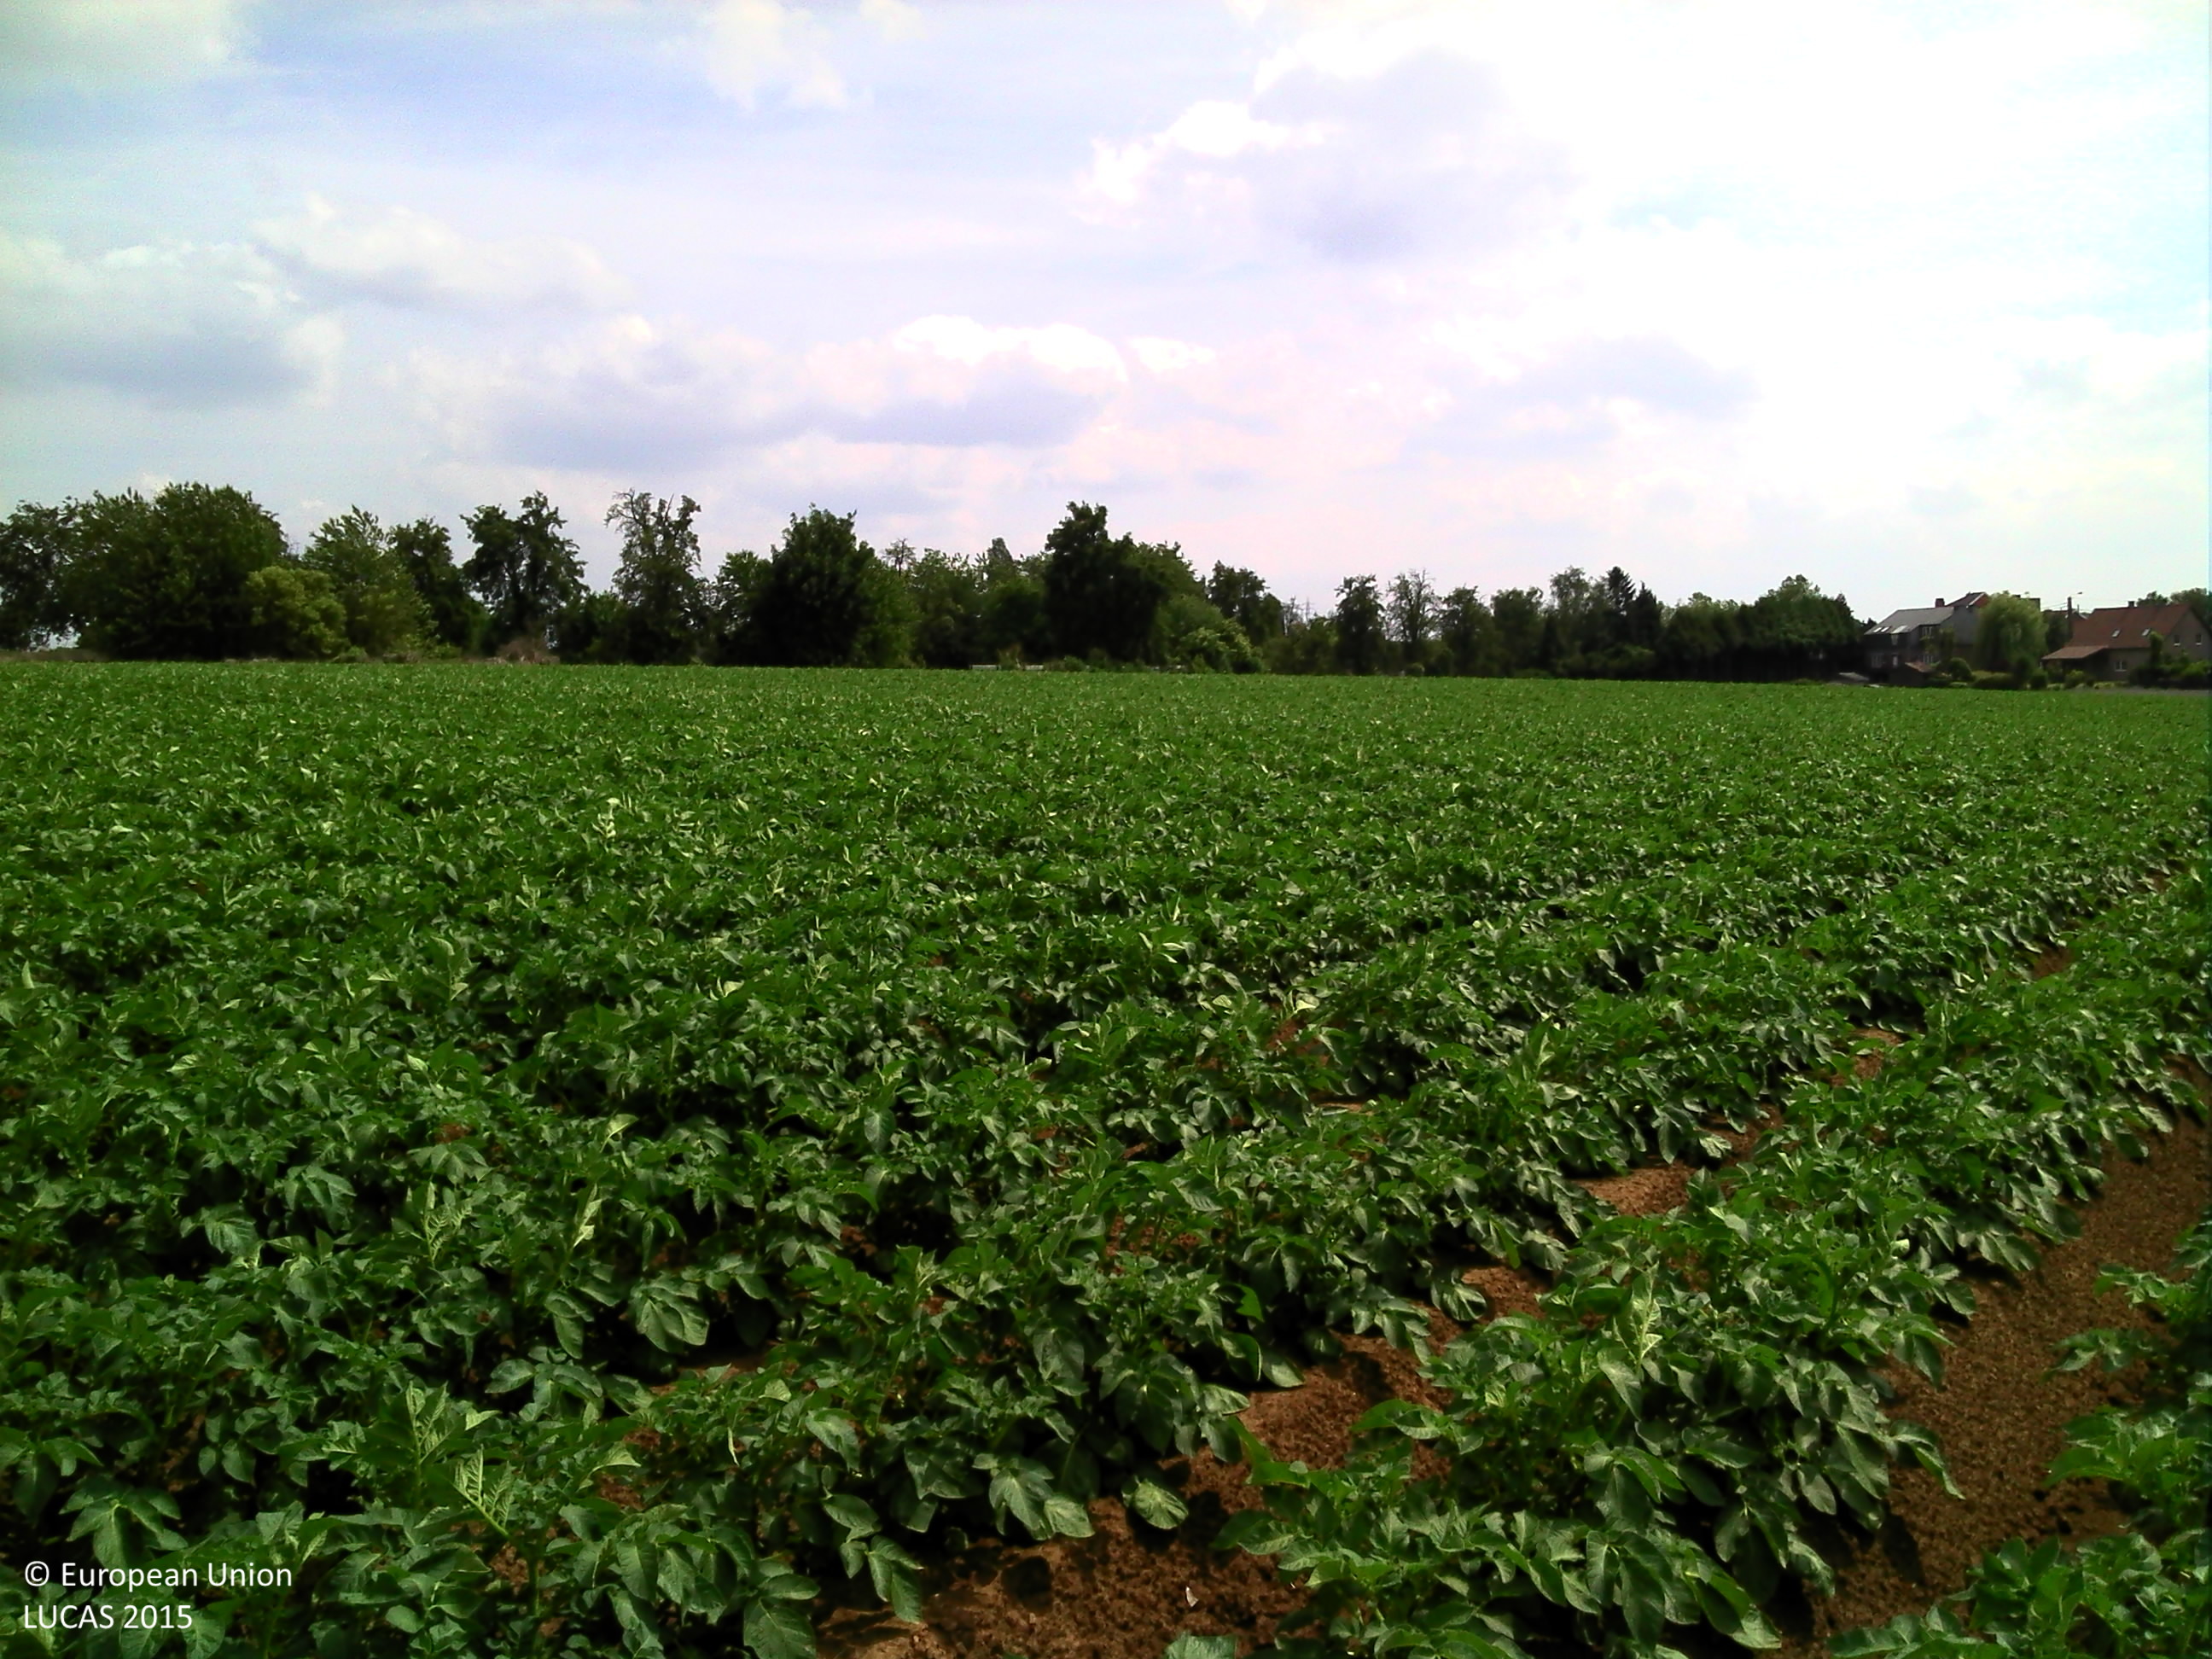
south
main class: Cropland
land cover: Potatoes
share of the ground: 50 - 75 %
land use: Agriculture (excluding fallow land and kitchen gardens)
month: June
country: BE
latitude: 50.6913
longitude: 5.5392
